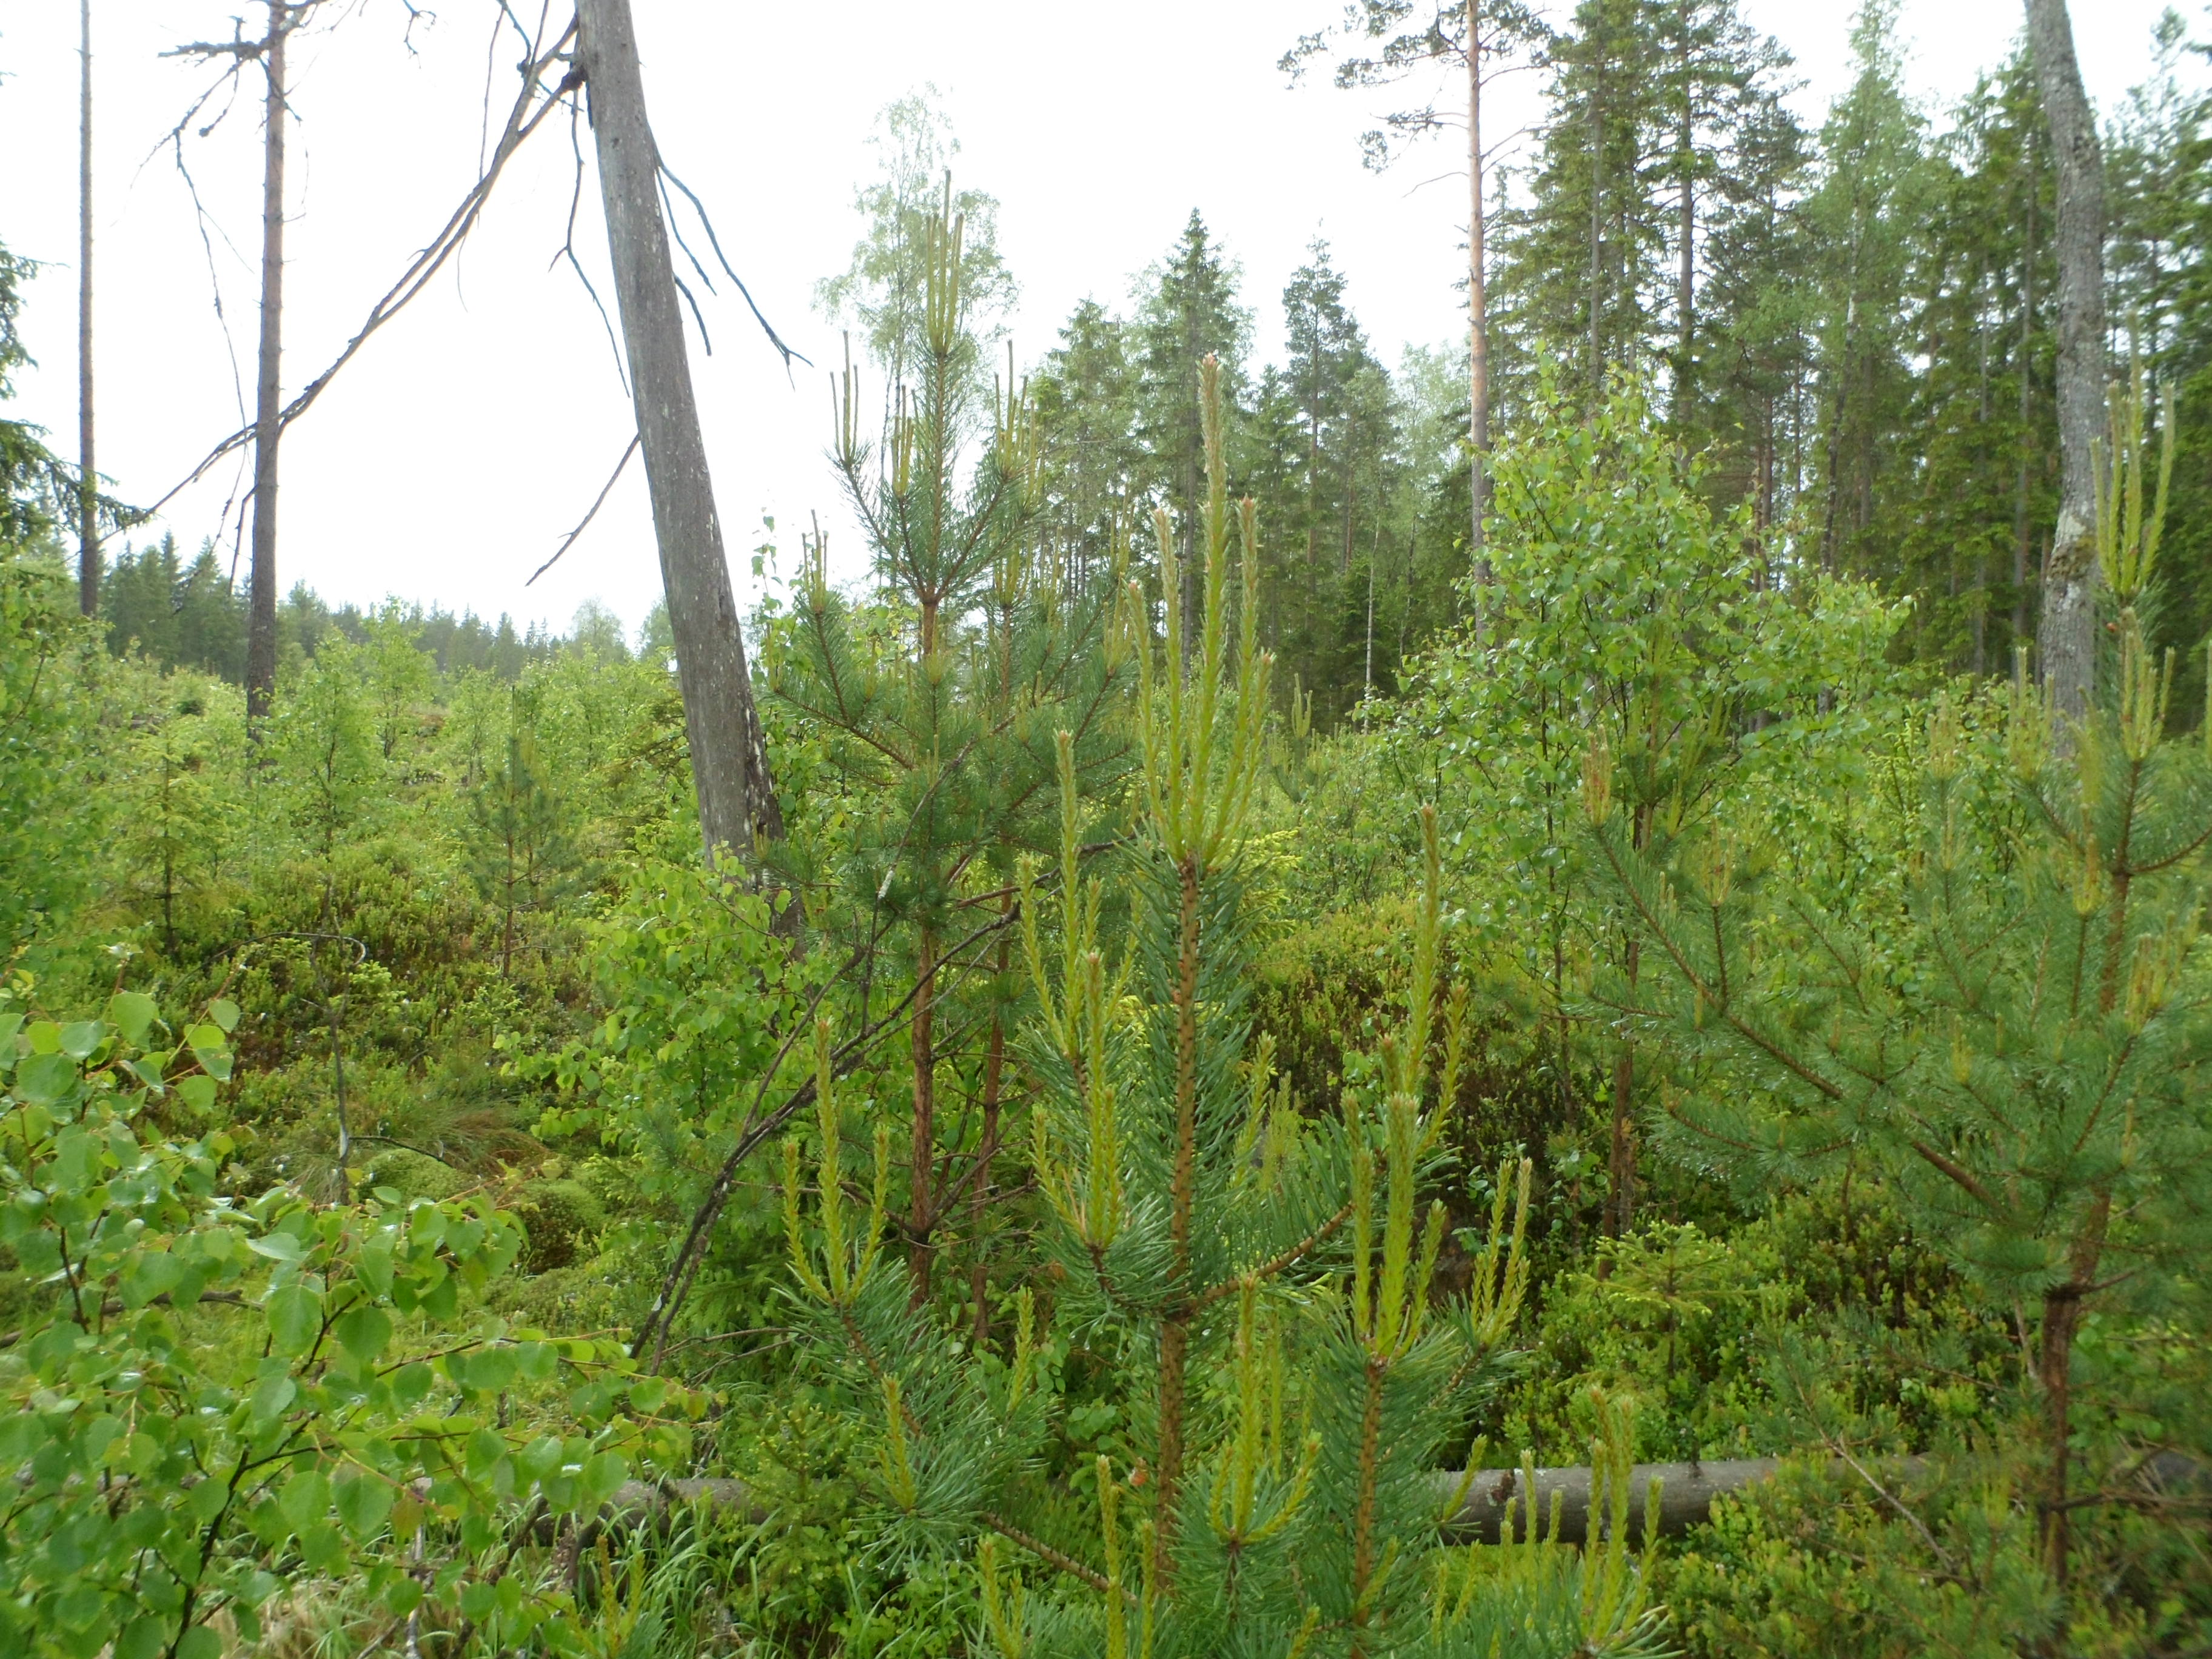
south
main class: Woodland
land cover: Pine dominated mixed woodland
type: boreal forest
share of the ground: 50 - 75 %
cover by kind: shrubs 30 %, coniferous forest trees 25 %, broadleaved forest trees 25 %, lichens and mosses 15 %, herbaceous plants 5 %
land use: Forestry
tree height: < 5 m
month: June
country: SE
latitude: 56.9064
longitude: 14.3484
